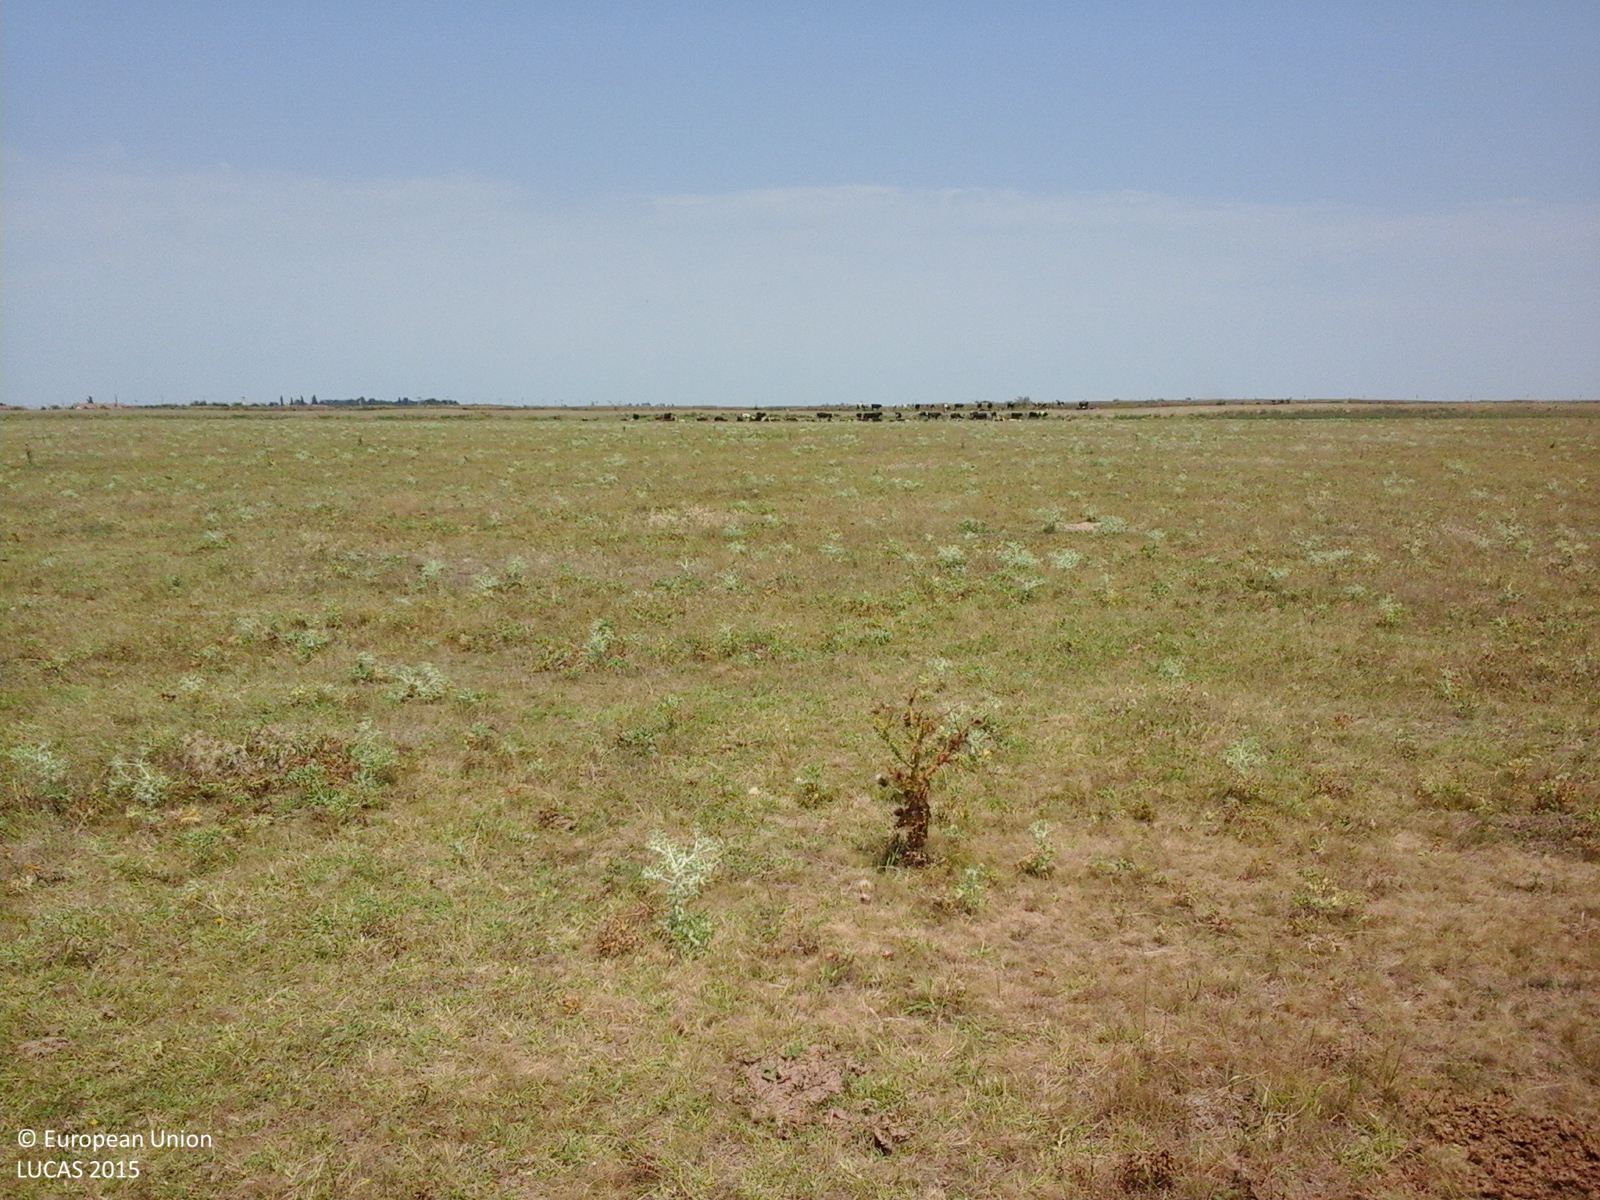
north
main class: Grassland
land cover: Grassland without tree/shrub cover
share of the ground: > 75 %
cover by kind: herbaceous plants 100 %
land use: Agriculture (excluding fallow land and kitchen gardens)
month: July
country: RO
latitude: 44.9560
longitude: 27.2406
